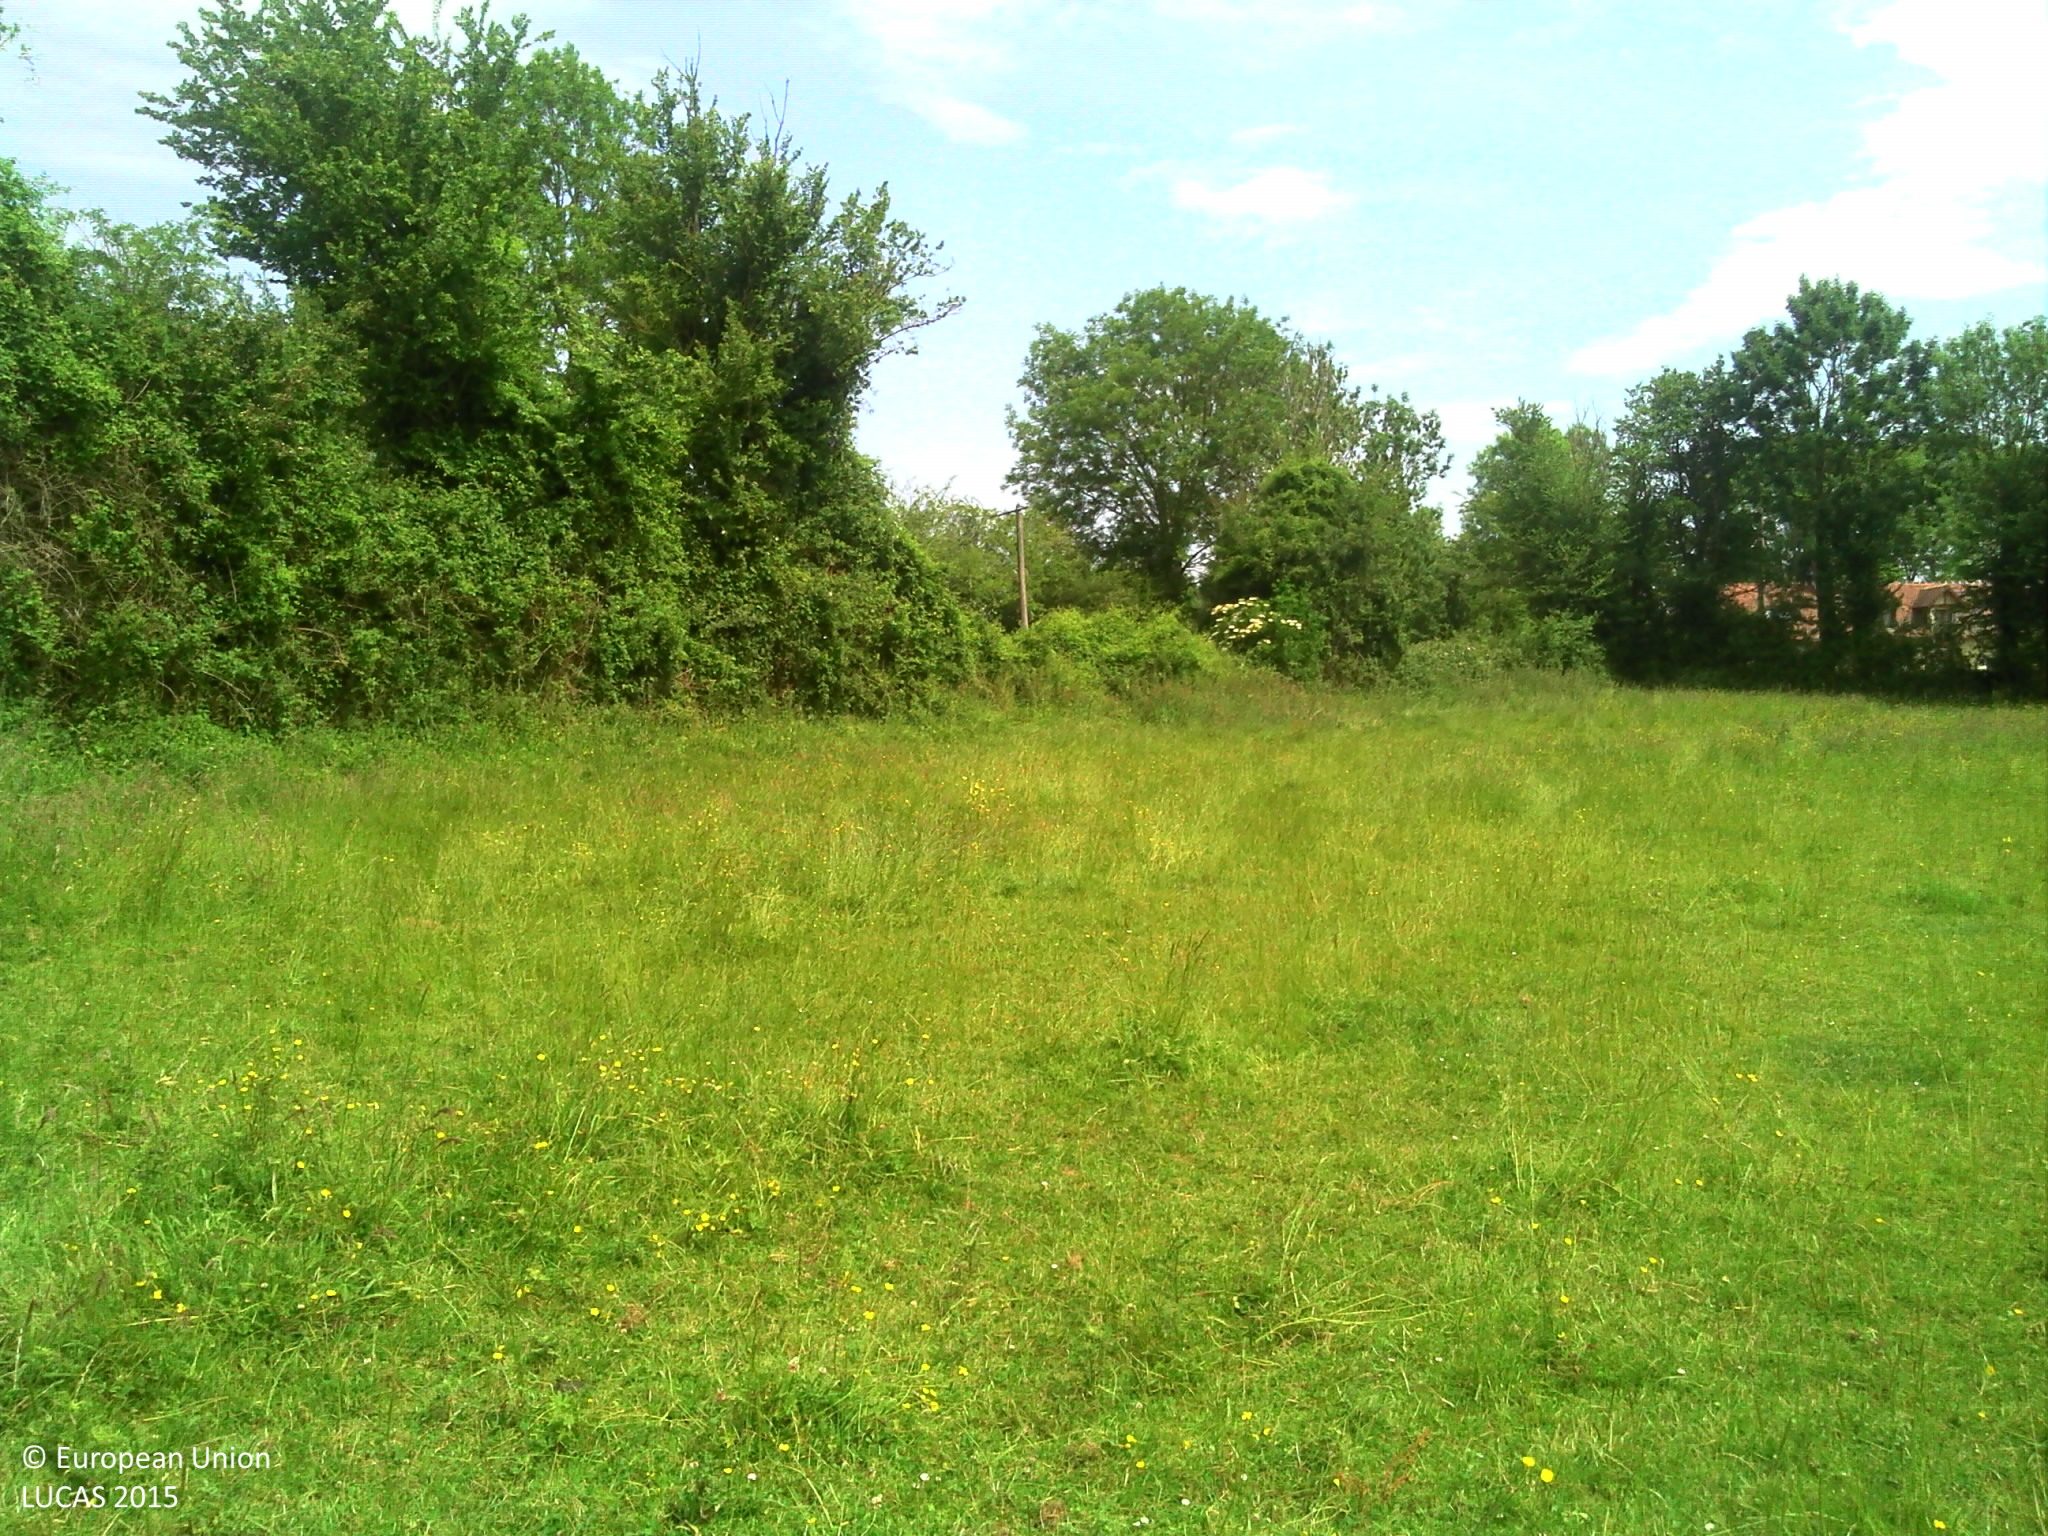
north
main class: Grassland
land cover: Grassland without tree/shrub cover
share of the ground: > 75 %
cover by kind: herbaceous plants 100 %
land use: Agriculture (excluding fallow land and kitchen gardens)
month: June
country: FR
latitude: 48.5298
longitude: 0.2089
